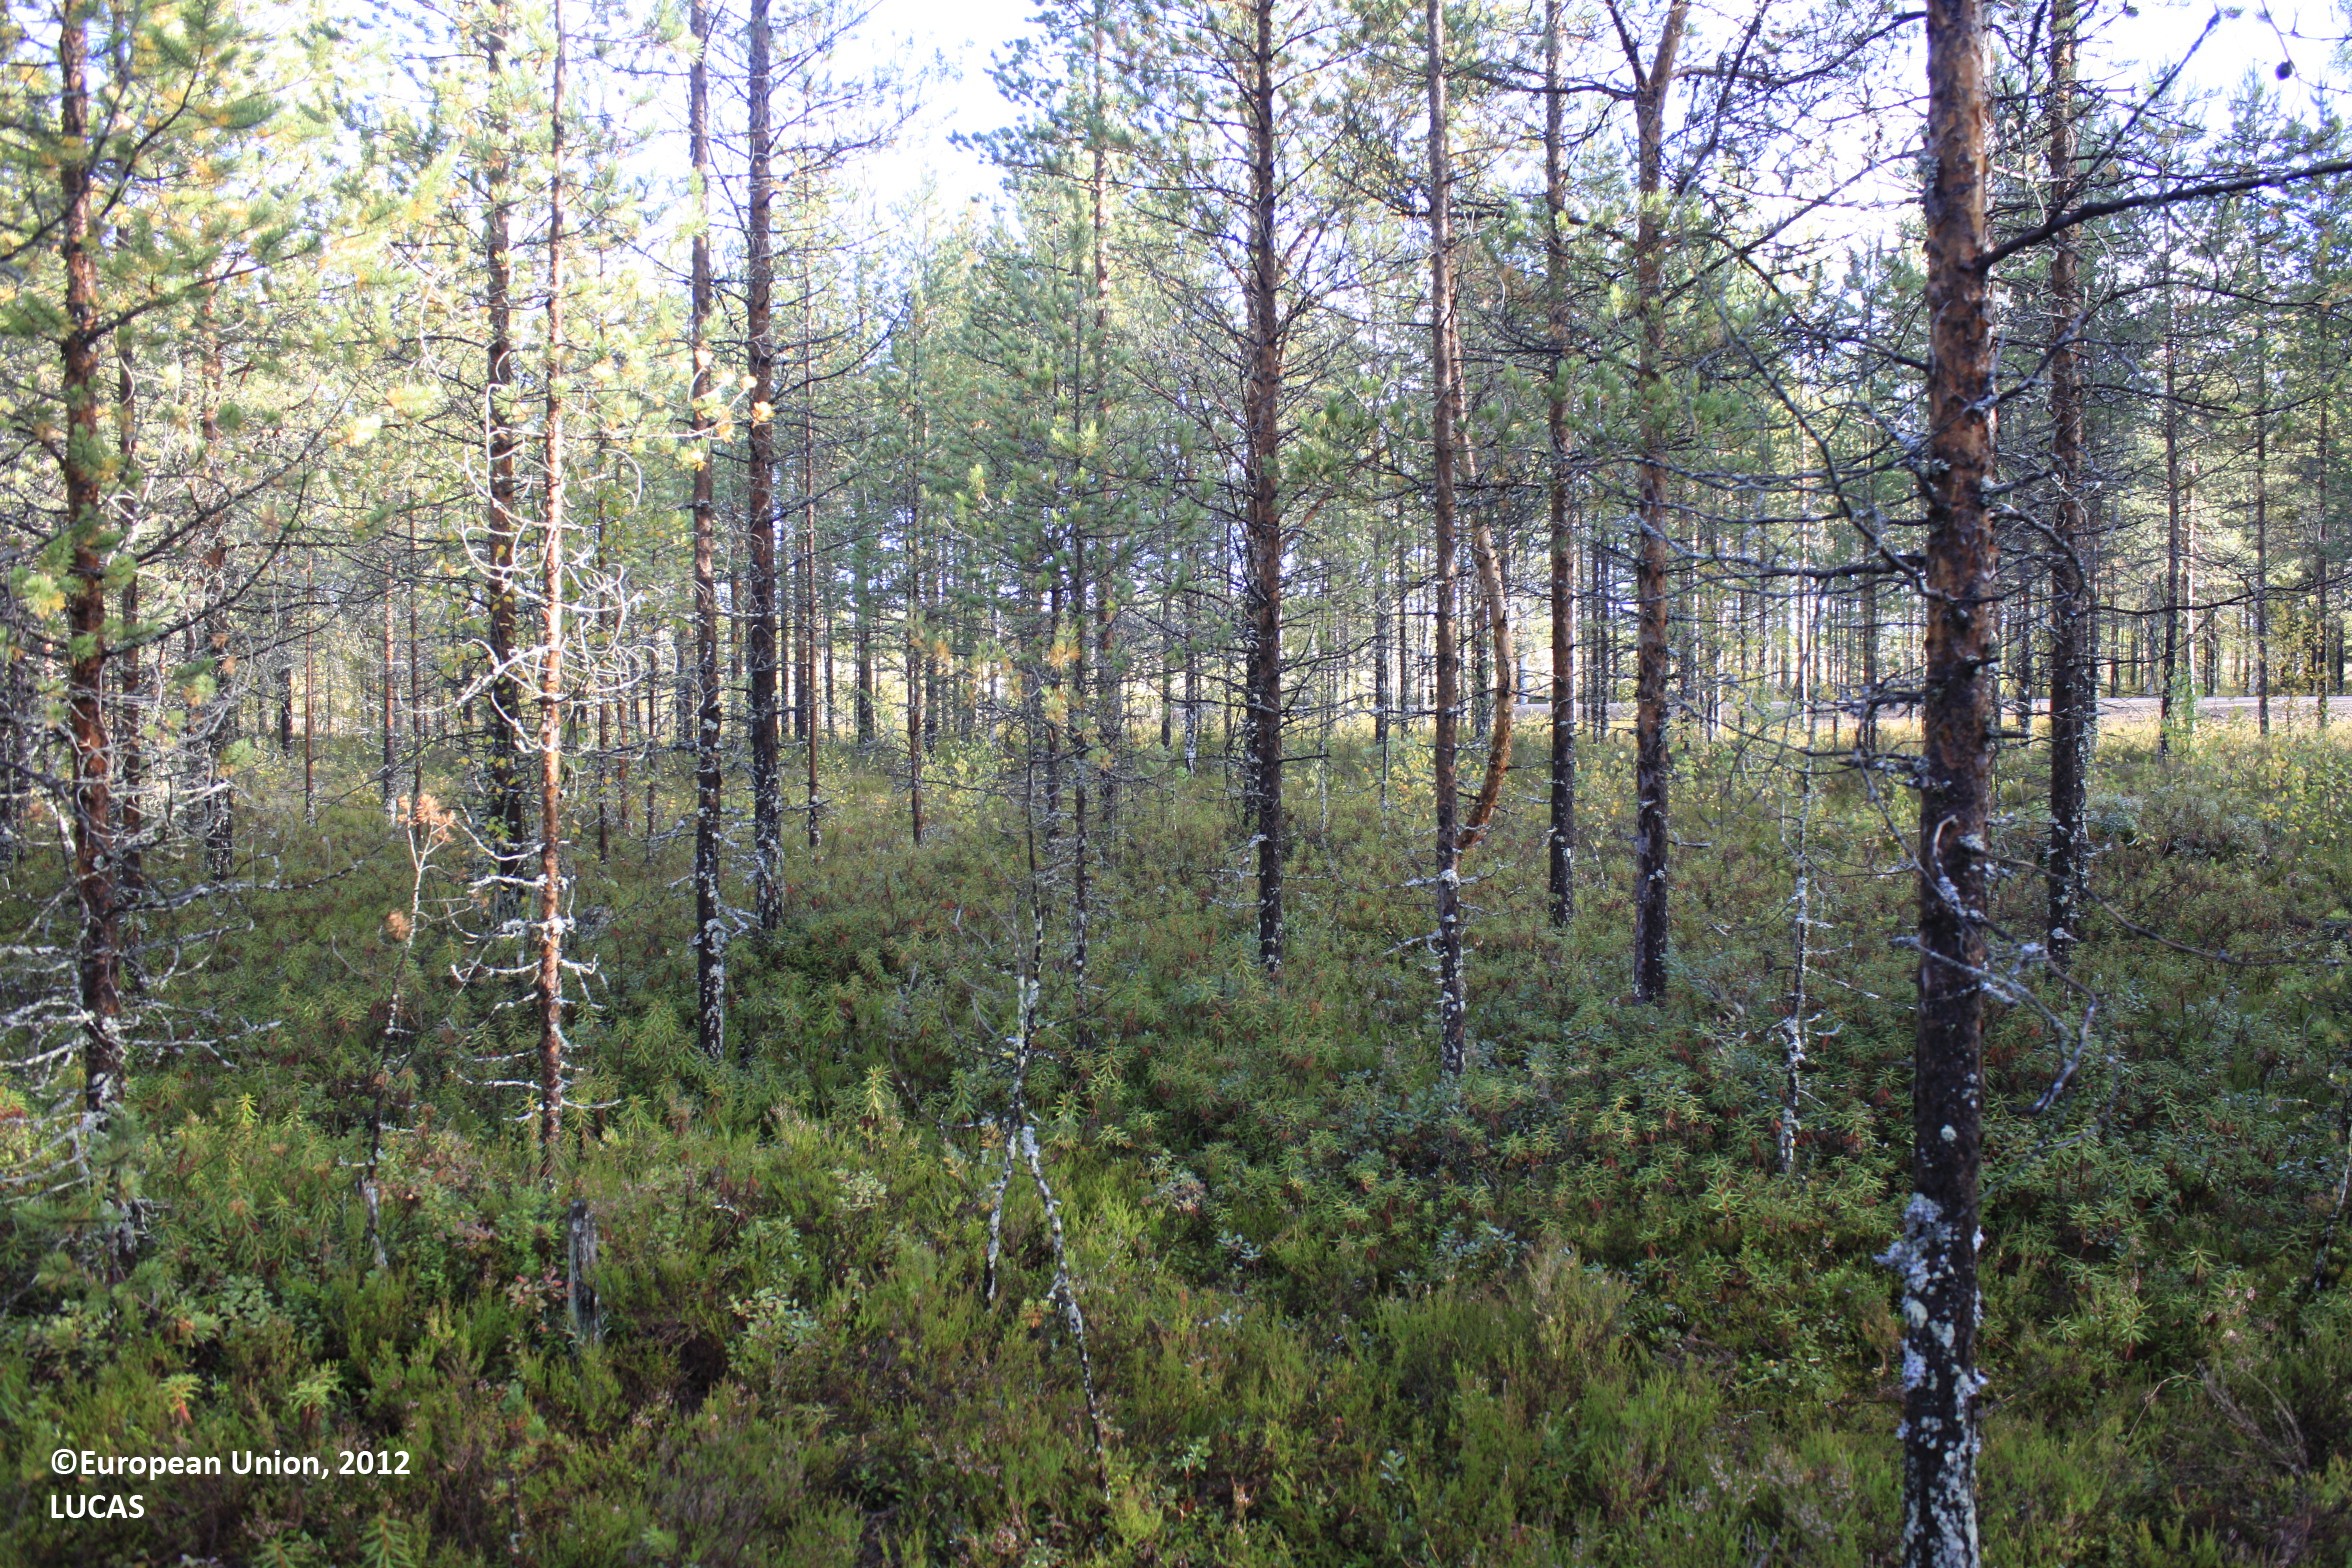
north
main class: Woodland
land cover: Pine dominated coniferous woodland
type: boreal forest
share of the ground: 25 - 50 %
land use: Forestry
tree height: > 5 m
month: September
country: FI
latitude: 65.2664
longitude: 27.0632
